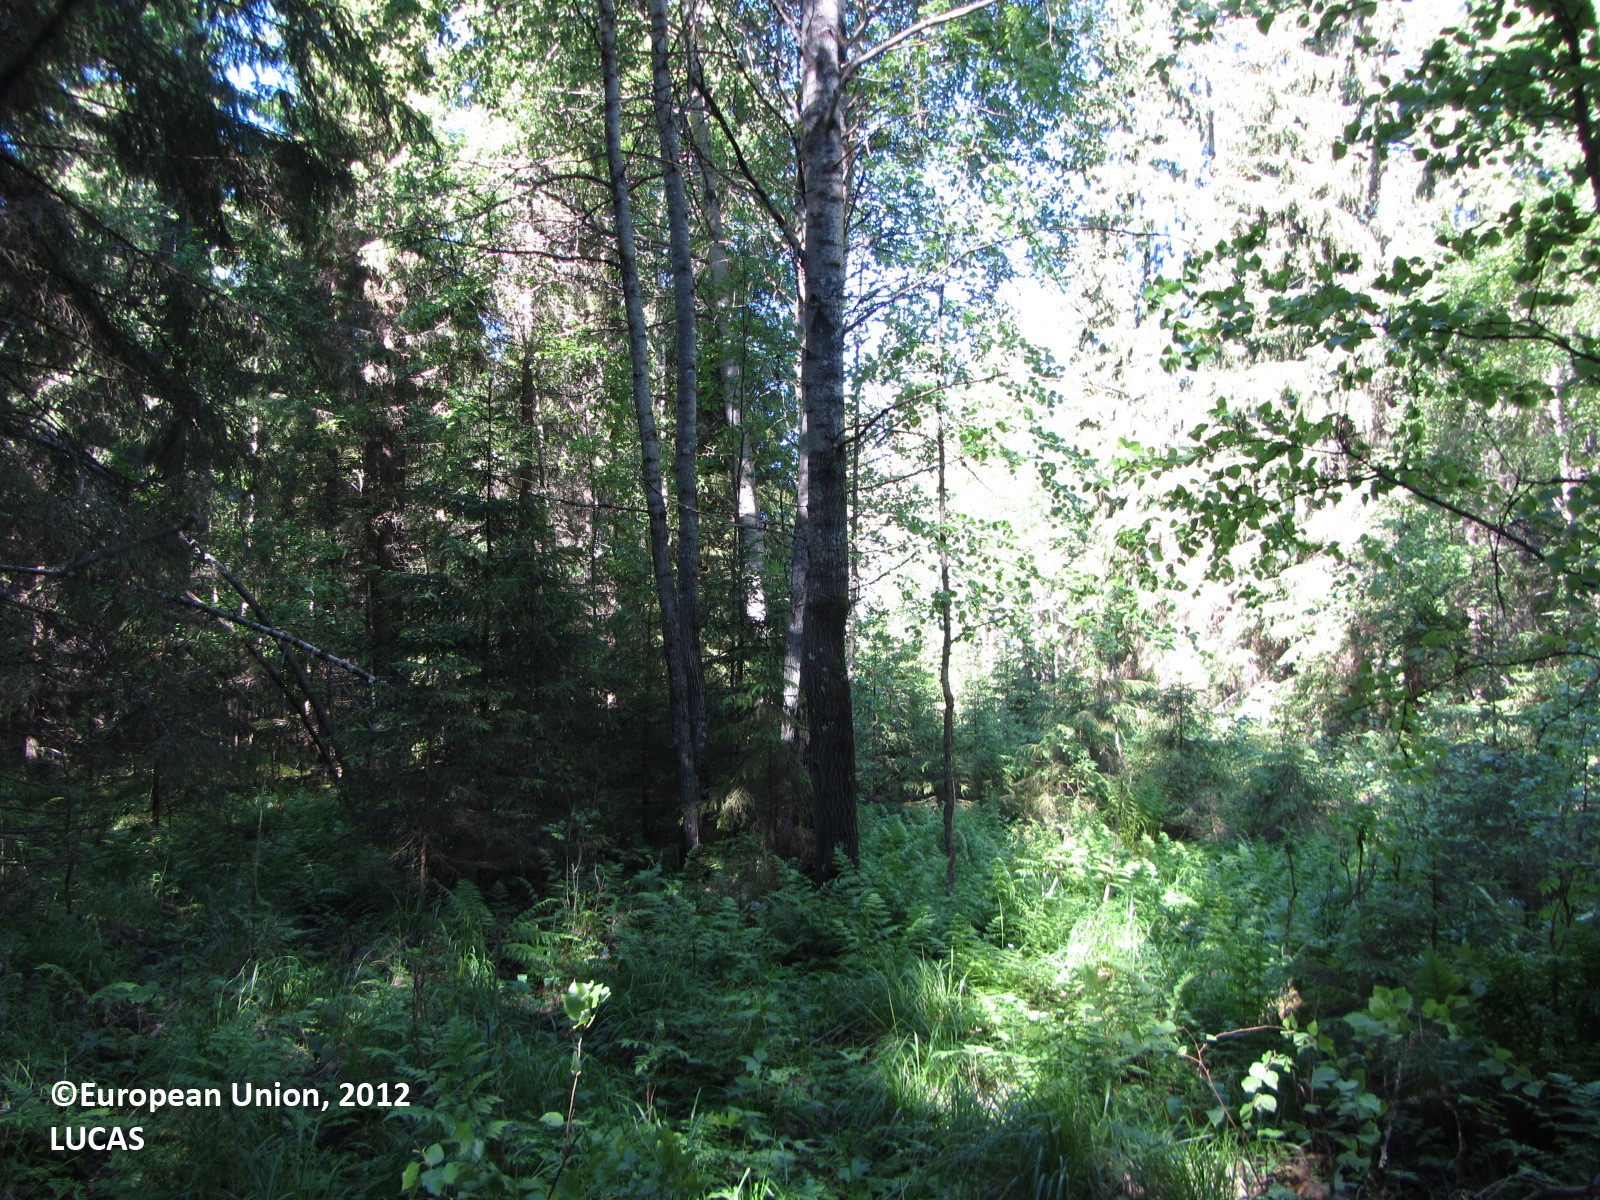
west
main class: Woodland
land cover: Spruce dominated mixed woodland
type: boreal forest
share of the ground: 50 - 75 %
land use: Forestry
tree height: > 5 m
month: June
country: FI
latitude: 62.0174
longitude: 25.7306
